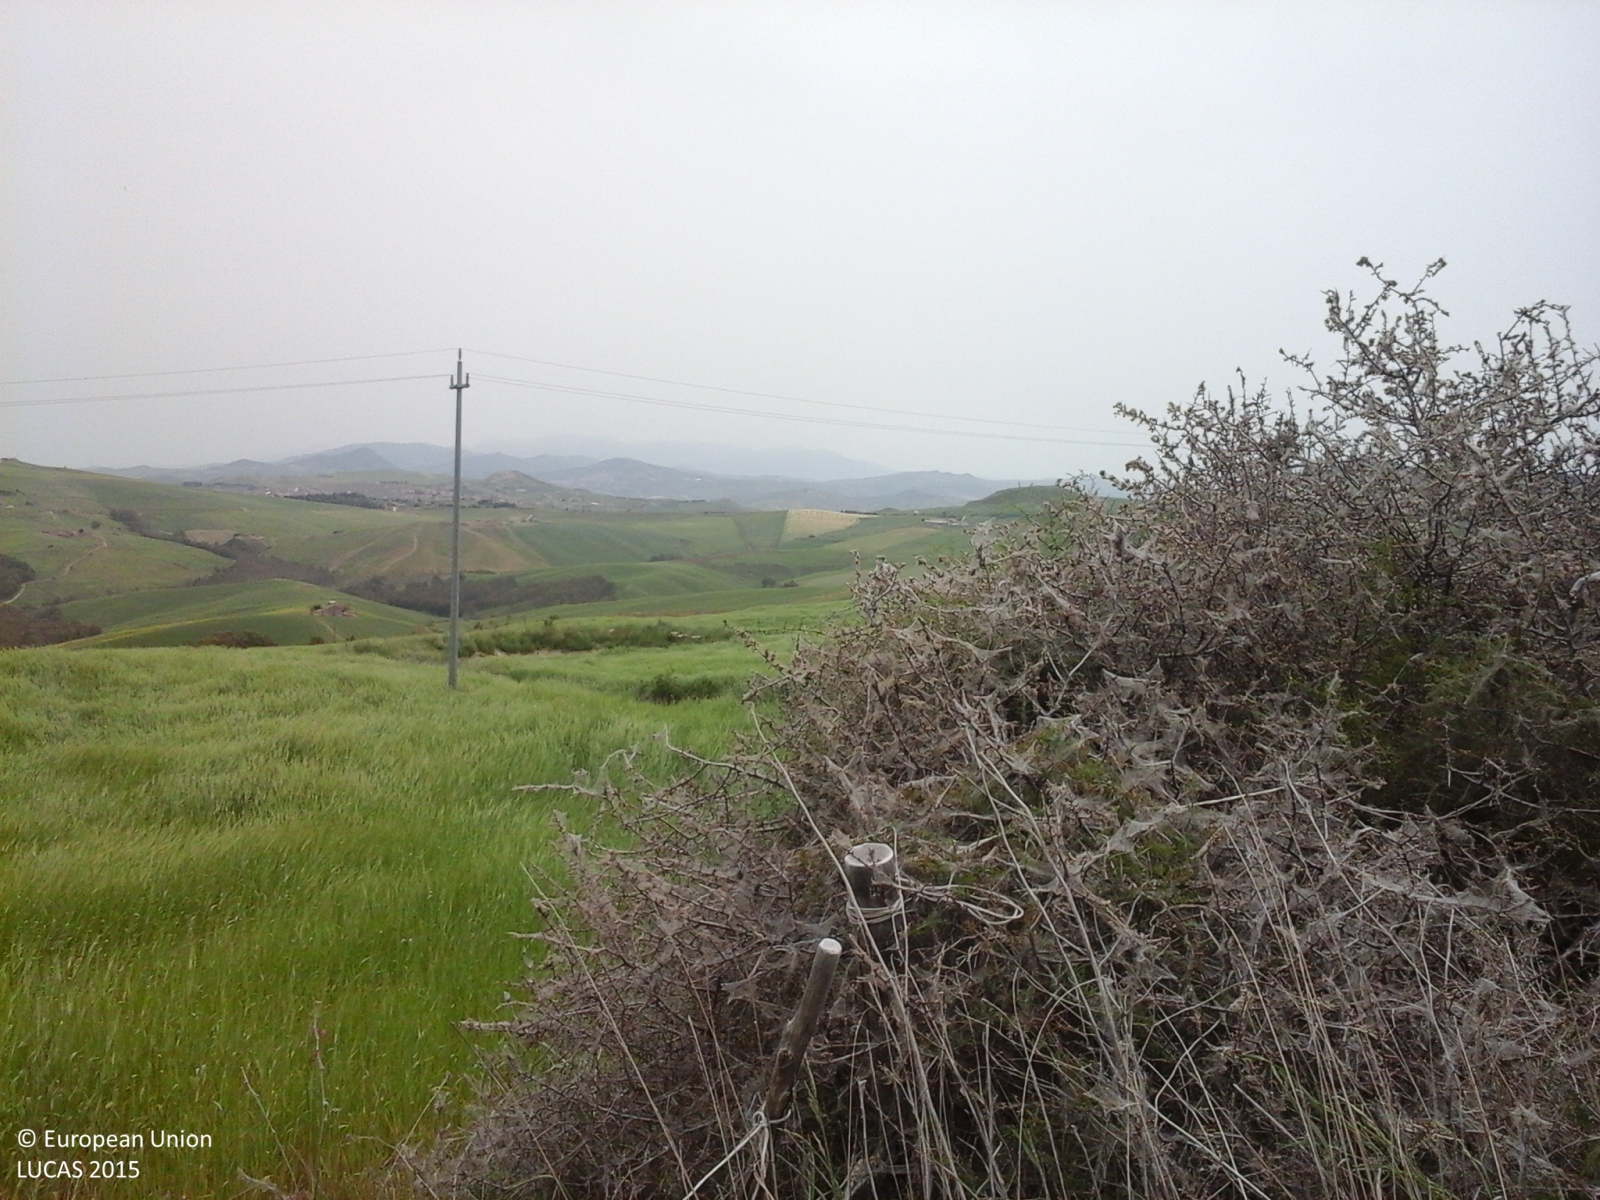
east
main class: Cropland
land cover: Durum wheat
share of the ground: > 75 %
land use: Agriculture (excluding fallow land and kitchen gardens)
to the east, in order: Durum wheat; Electric lines; Durum wheat; Ditches and canals; Grassland without tree/shrub cover; Electric lines; Grassland without tree/shrub cover
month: May
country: IT
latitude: 37.7177
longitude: 13.5474
